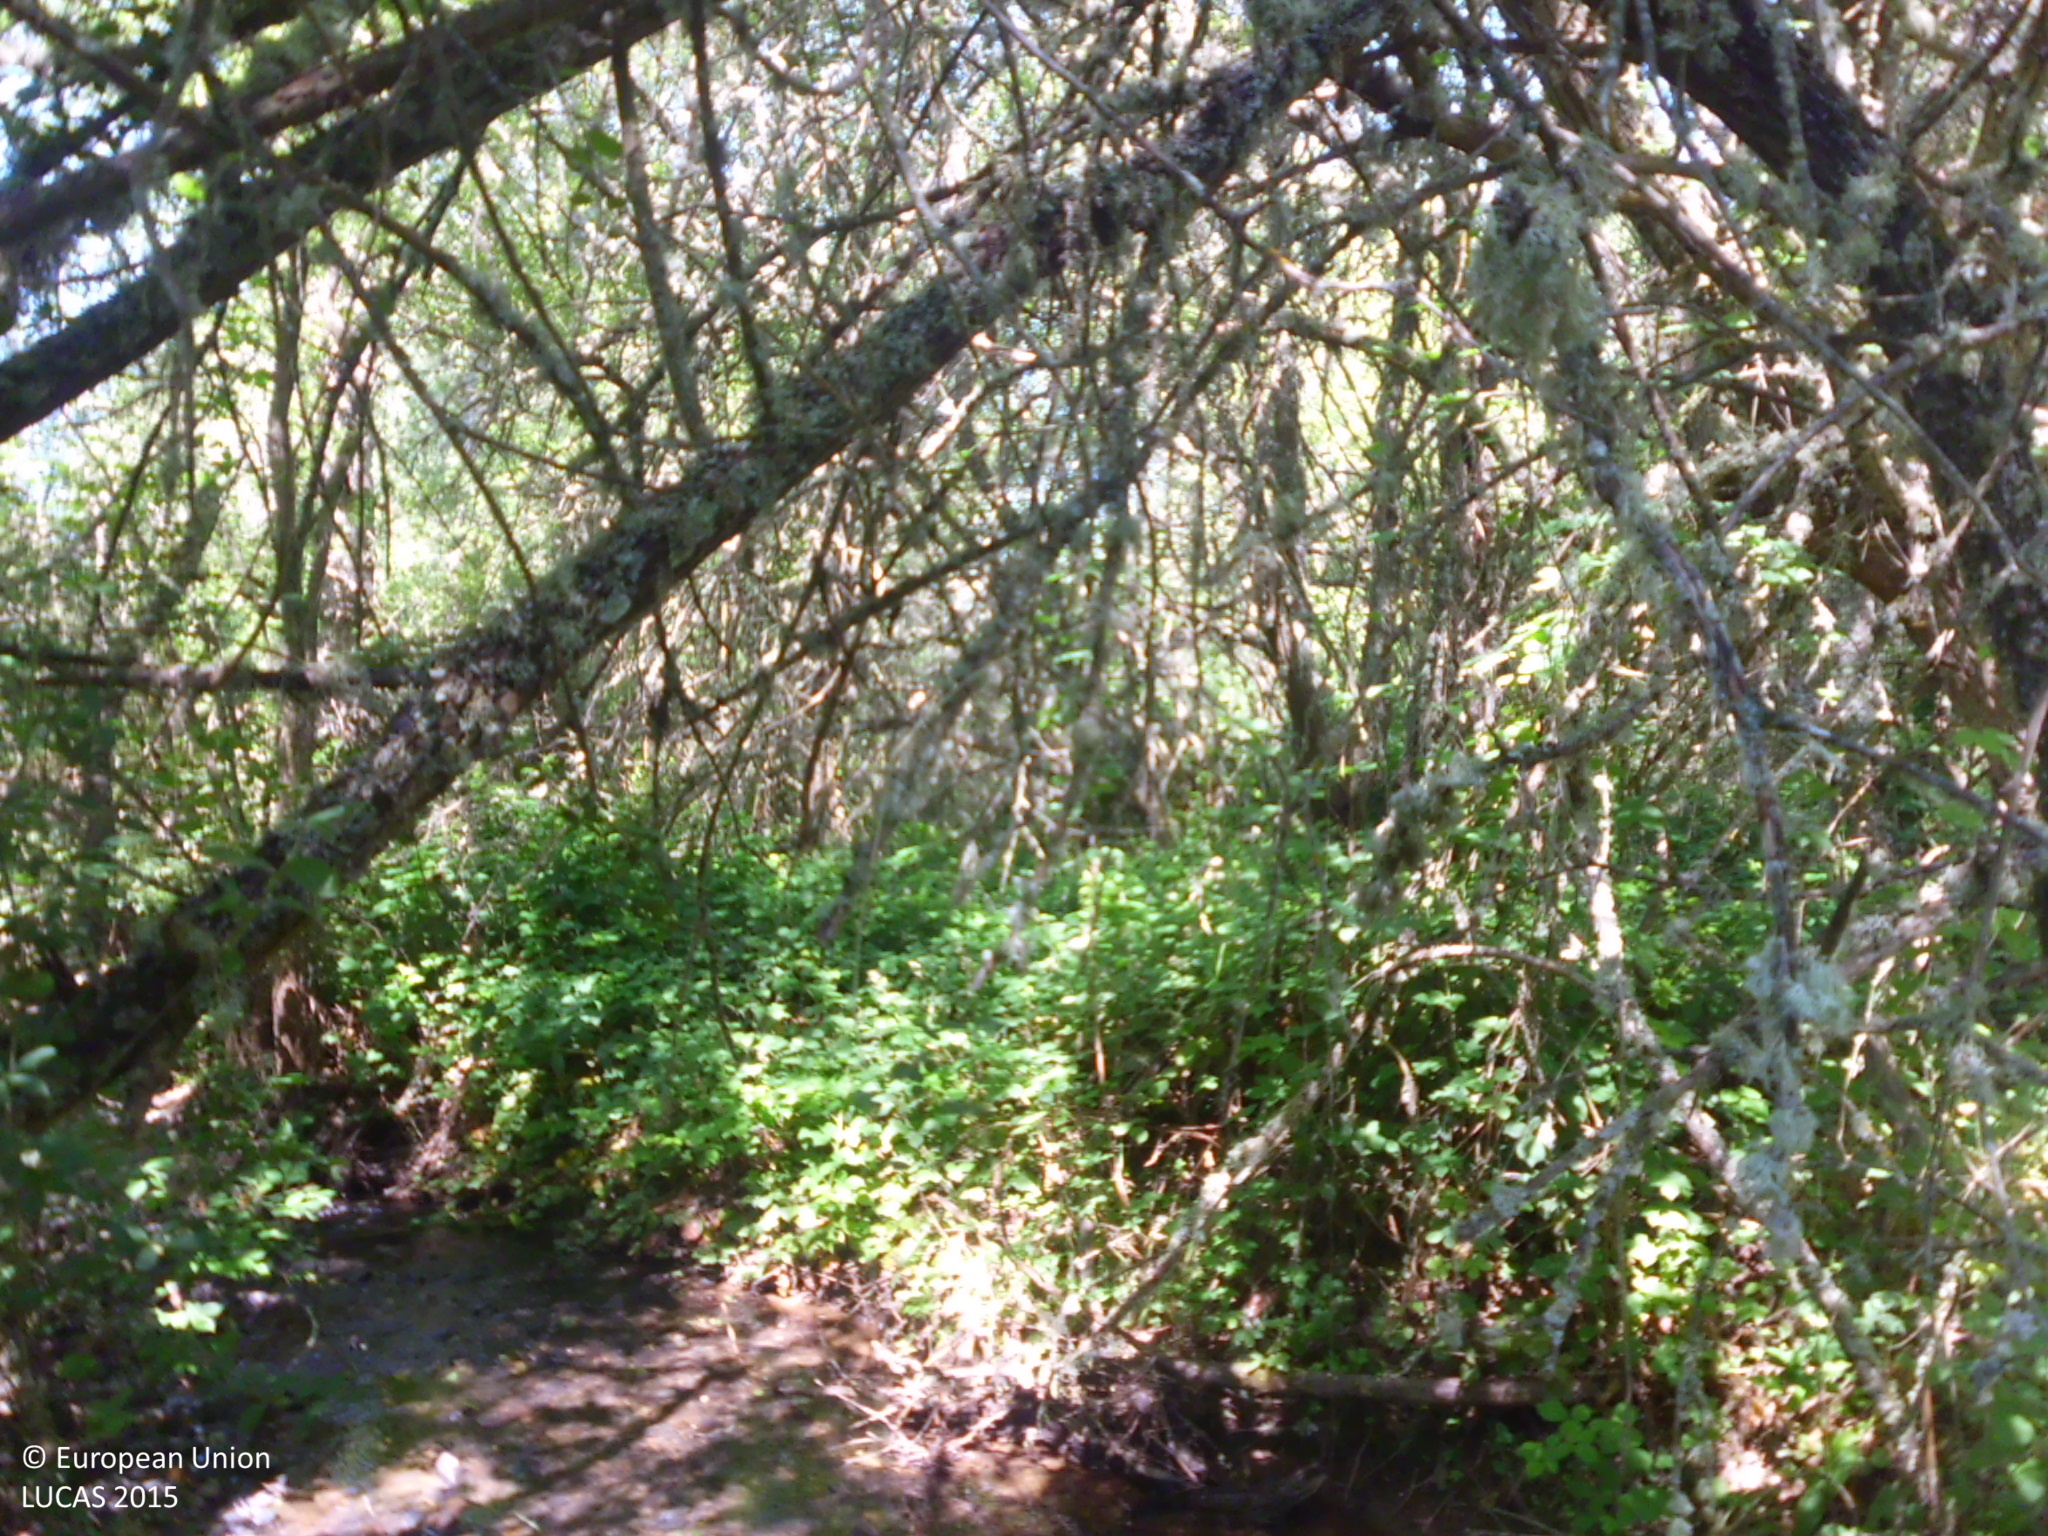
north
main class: Woodland
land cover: Broadleaved woodland
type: acidophilous oak and oak-birch forest
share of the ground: > 75 %
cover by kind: broadleaved forest trees 95 %, shrubs 5 %
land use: Semi-natural and natural areas not in use
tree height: > 5 m
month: July
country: ES
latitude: 42.3091
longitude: -3.3883
